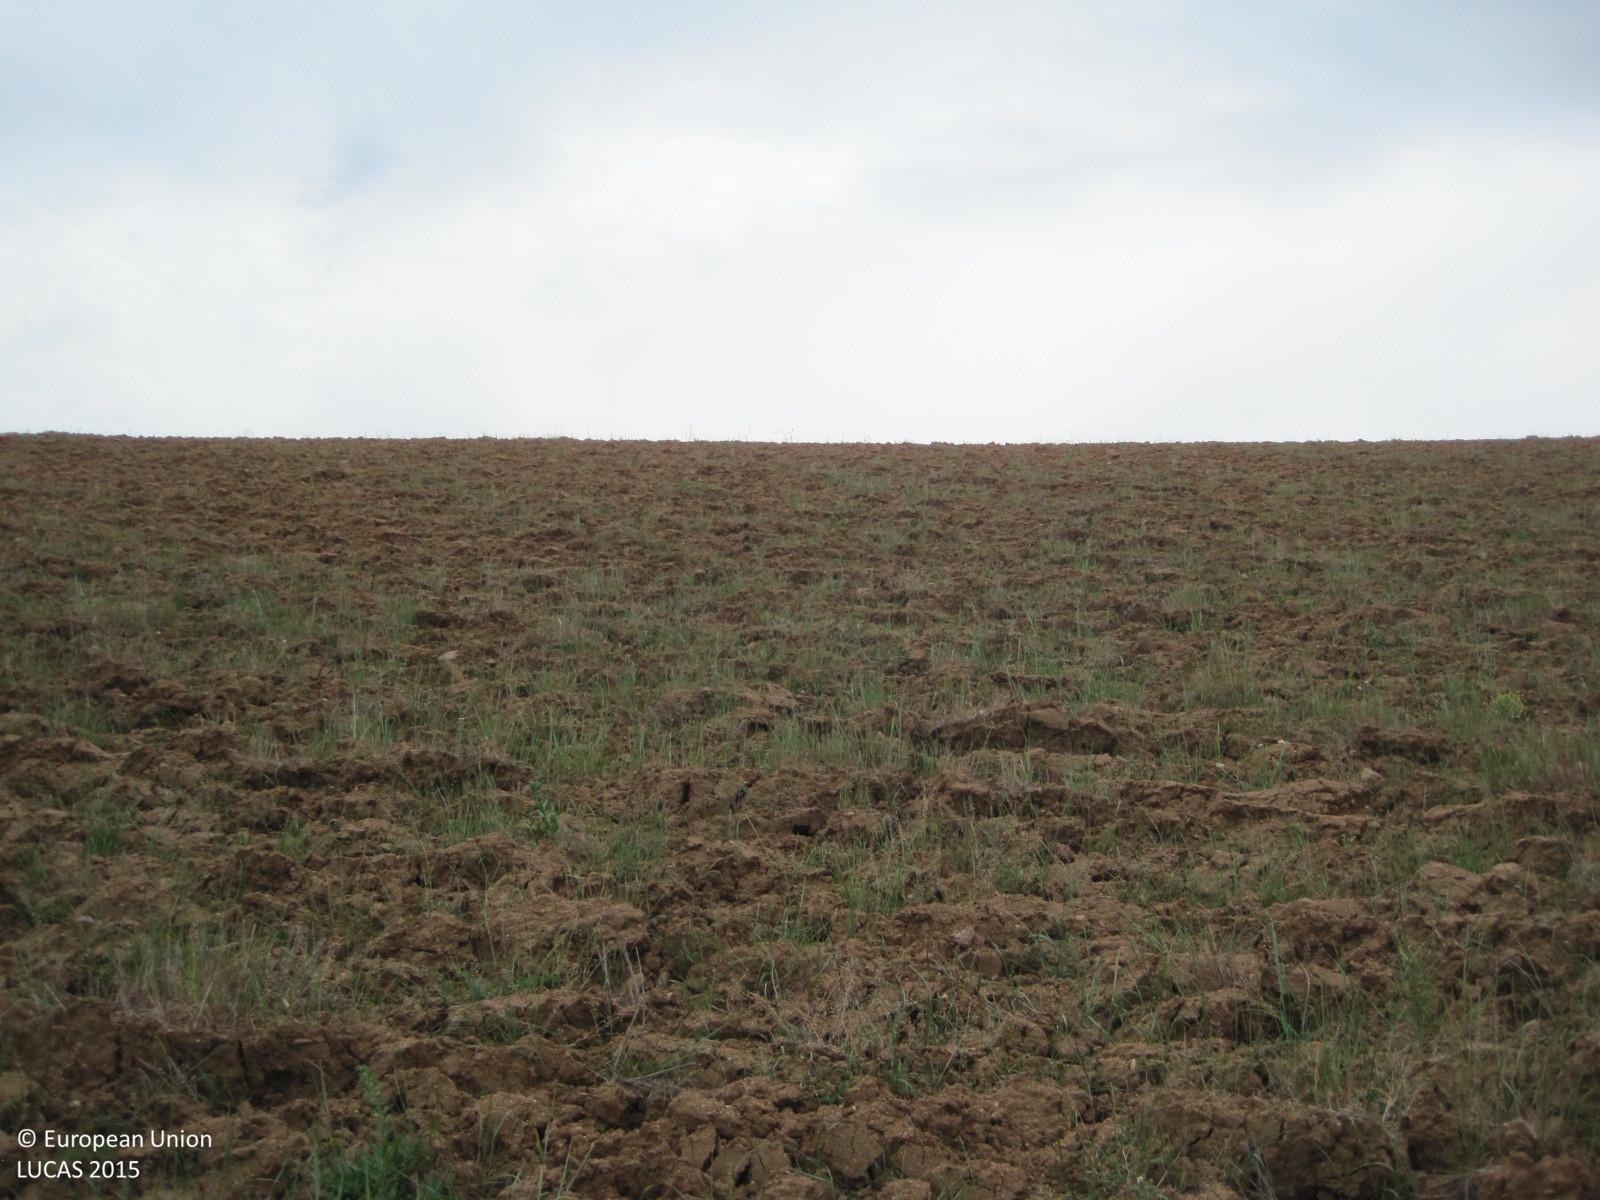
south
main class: Grassland
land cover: Spontaneously vegetated surfaces
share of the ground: 25 - 50 %
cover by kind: unconsolidated bare surface 70 %, herbaceous plants 30 %
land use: Fallow land
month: April
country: ES
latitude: 39.8822
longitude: -4.2450
